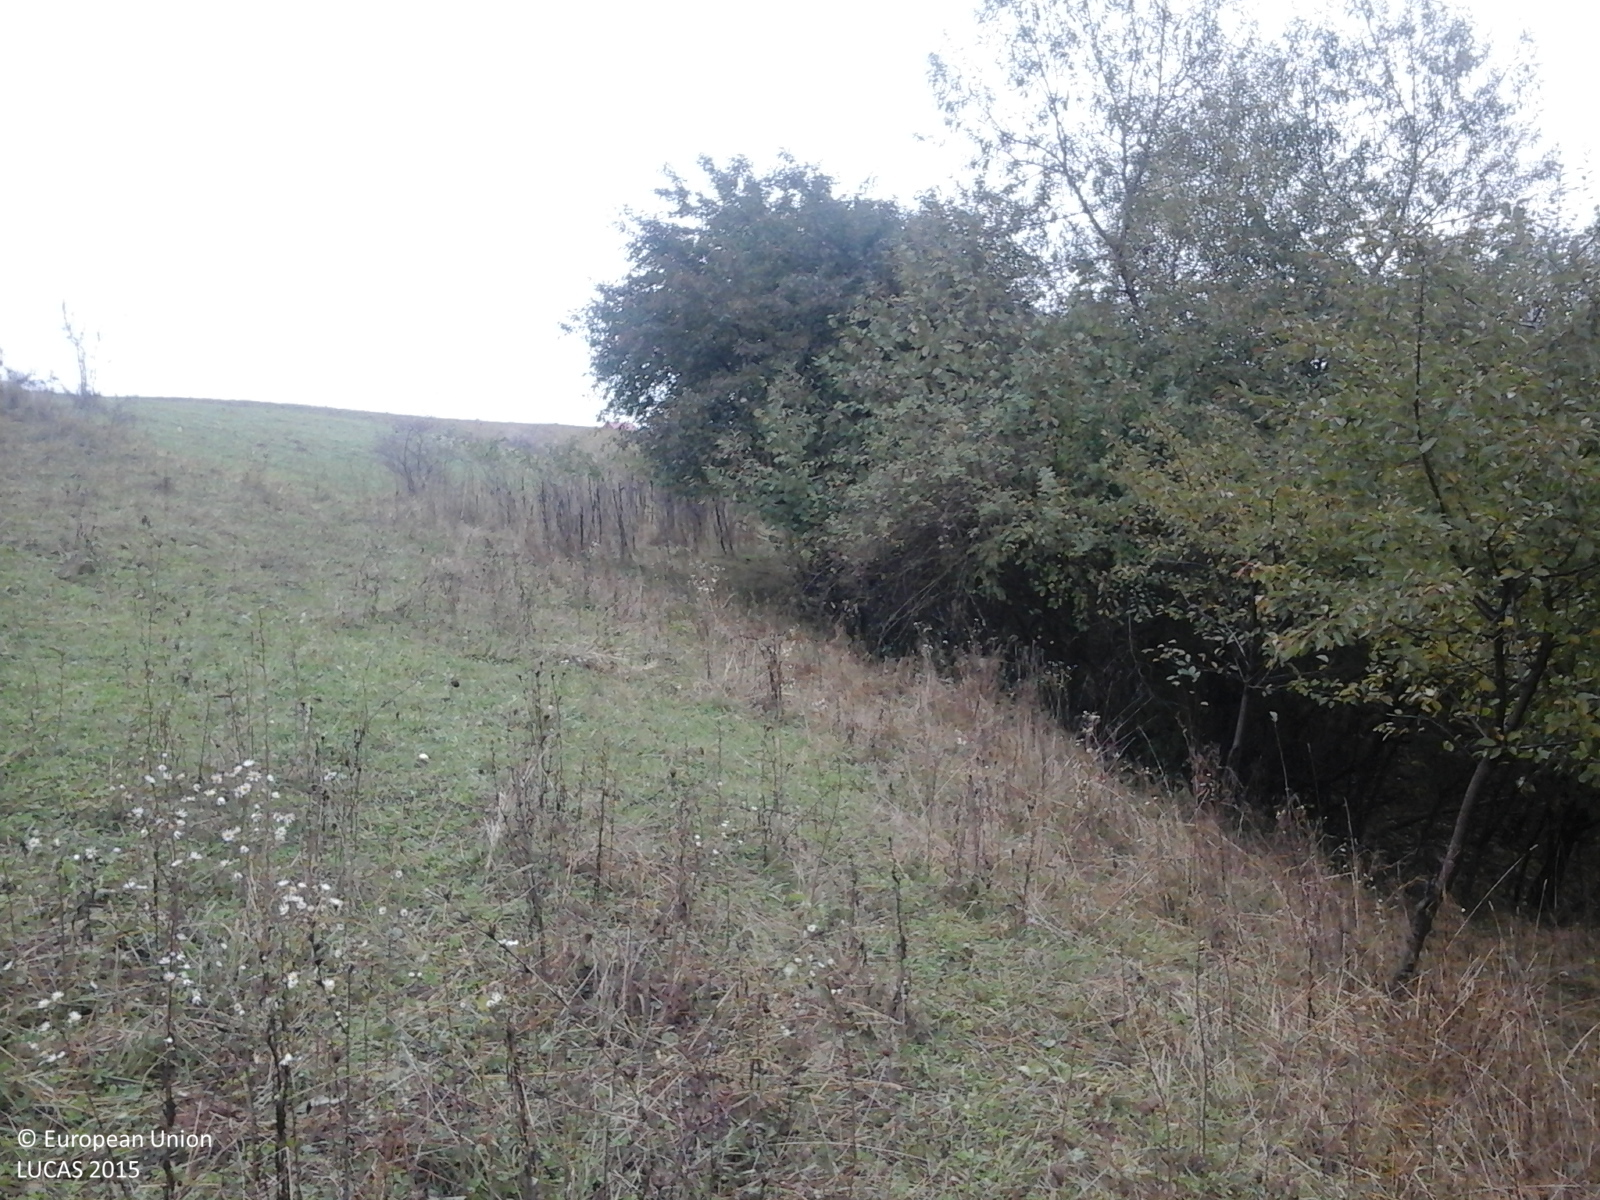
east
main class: Grassland
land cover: Spontaneously vegetated surfaces
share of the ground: > 75 %
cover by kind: herbaceous plants 100 %
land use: Fallow land
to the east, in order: Spontaneously vegetated surfaces; Cherry fruit; Grassland without tree/shrub cover; Shrubland without tree cover; Tracks; Shrubland without tree cover; Grassland without tree/shrub cover; Fences; Grassland without tree/shrub cover
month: October
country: RO
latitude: 45.7057
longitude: 24.0864
